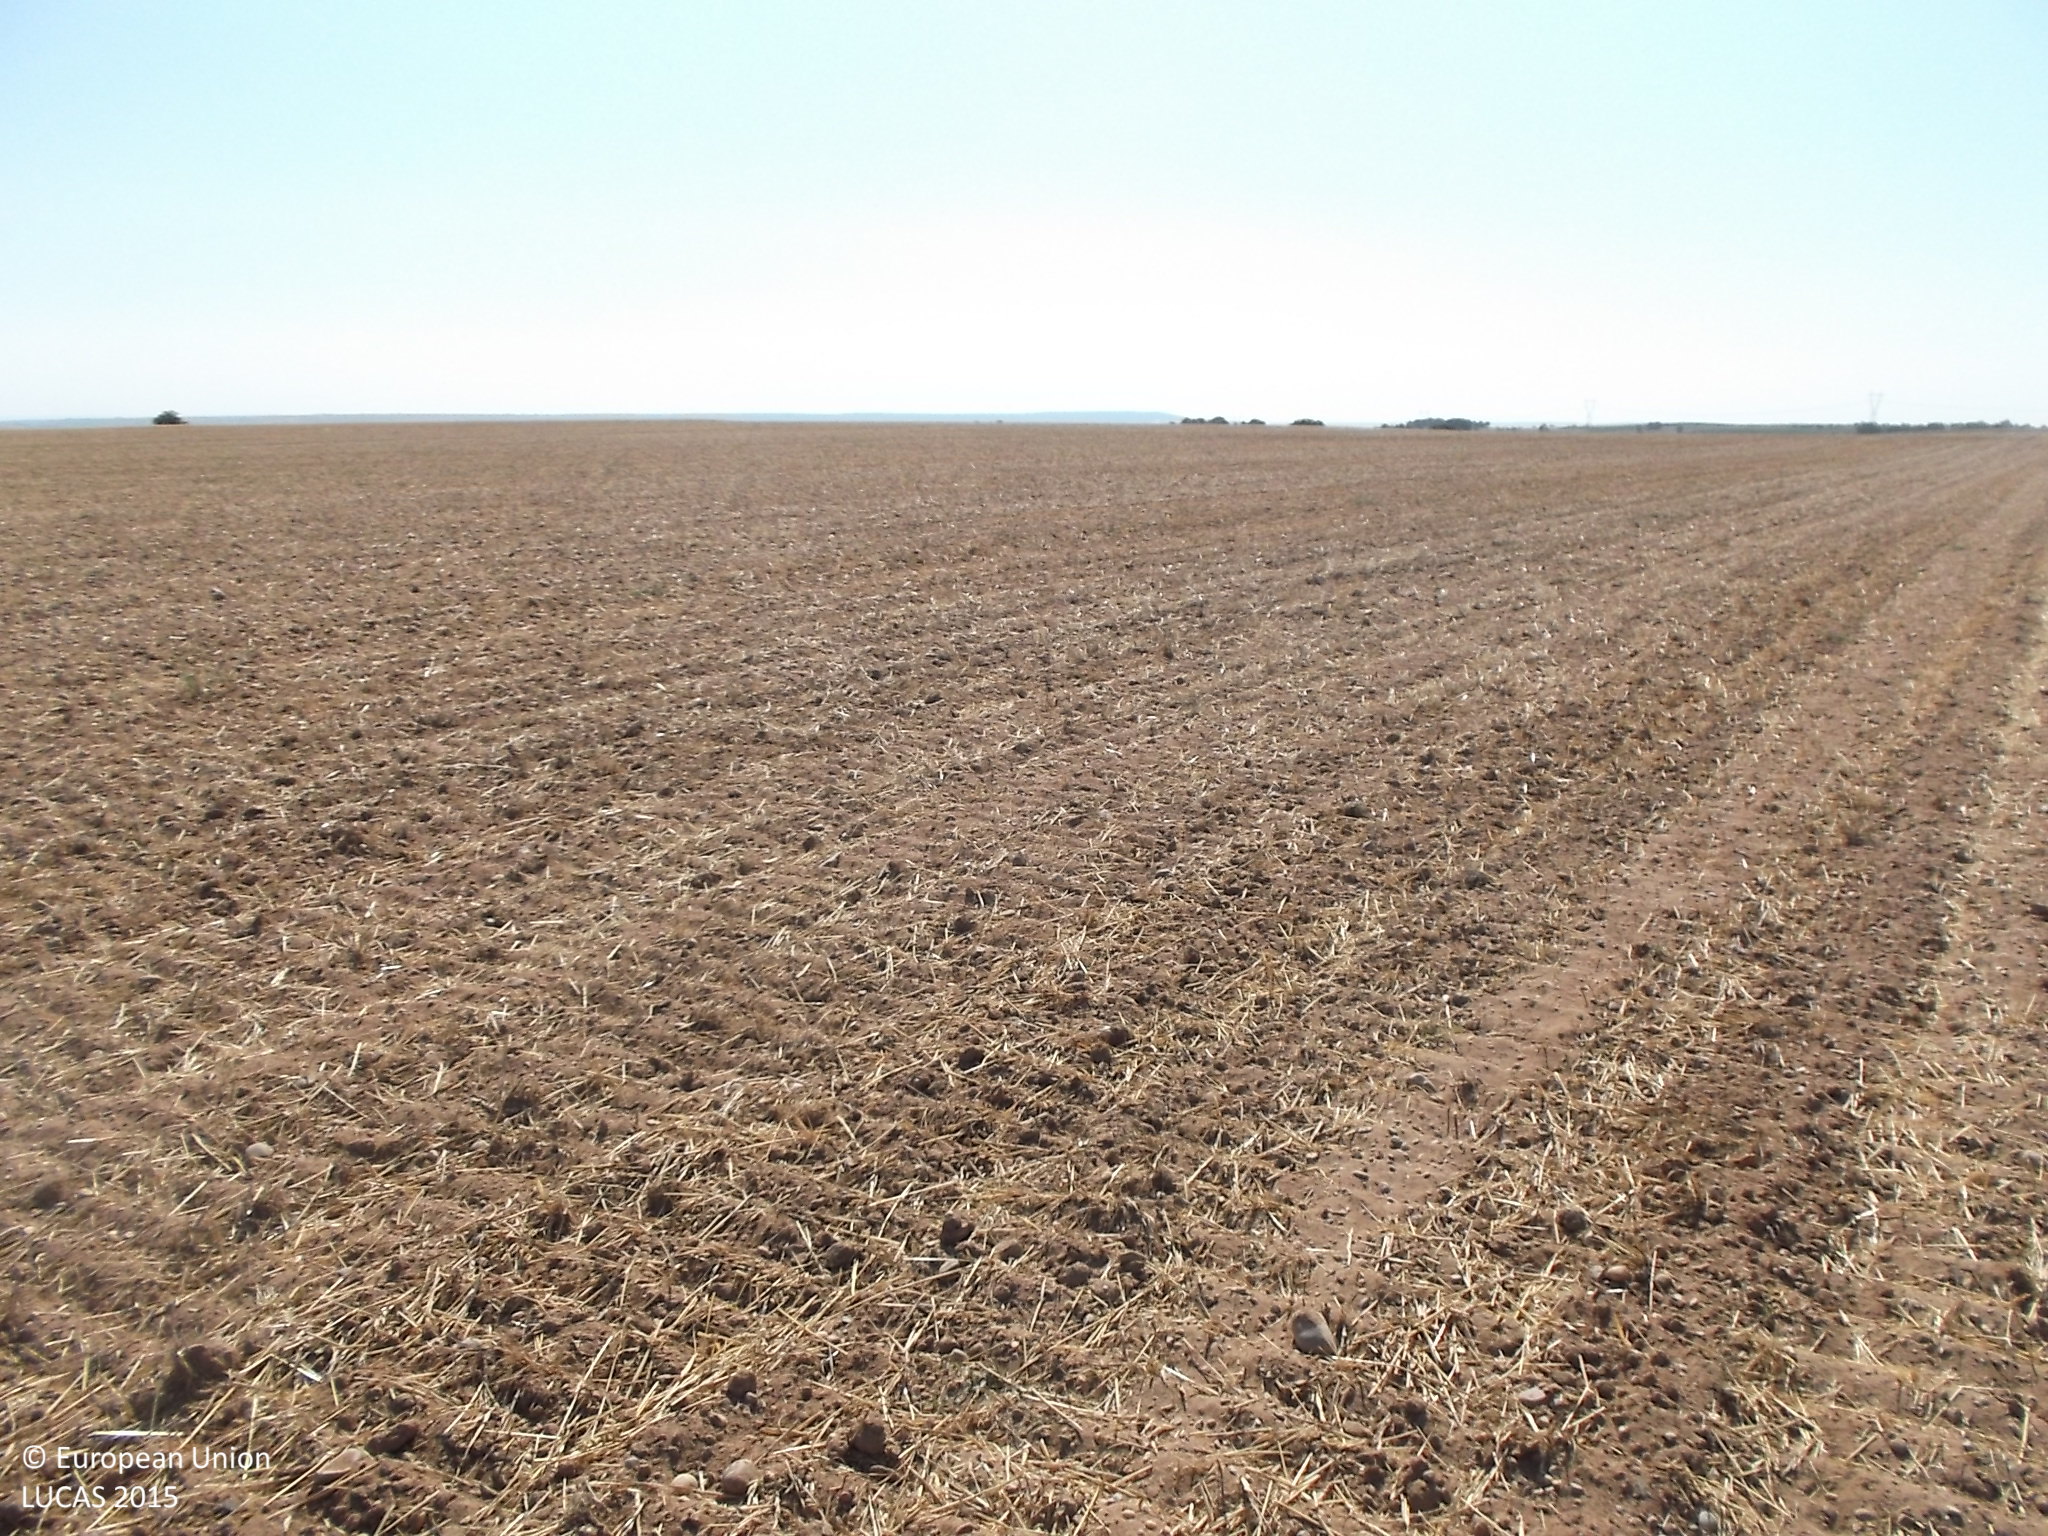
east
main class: Cropland
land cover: Oats
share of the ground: < 10 %
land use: Agriculture (excluding fallow land and kitchen gardens)
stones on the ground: 10 - 25 %
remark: Harvested field
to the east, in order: Oats
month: July
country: ES
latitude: 41.4551
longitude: -5.3655
